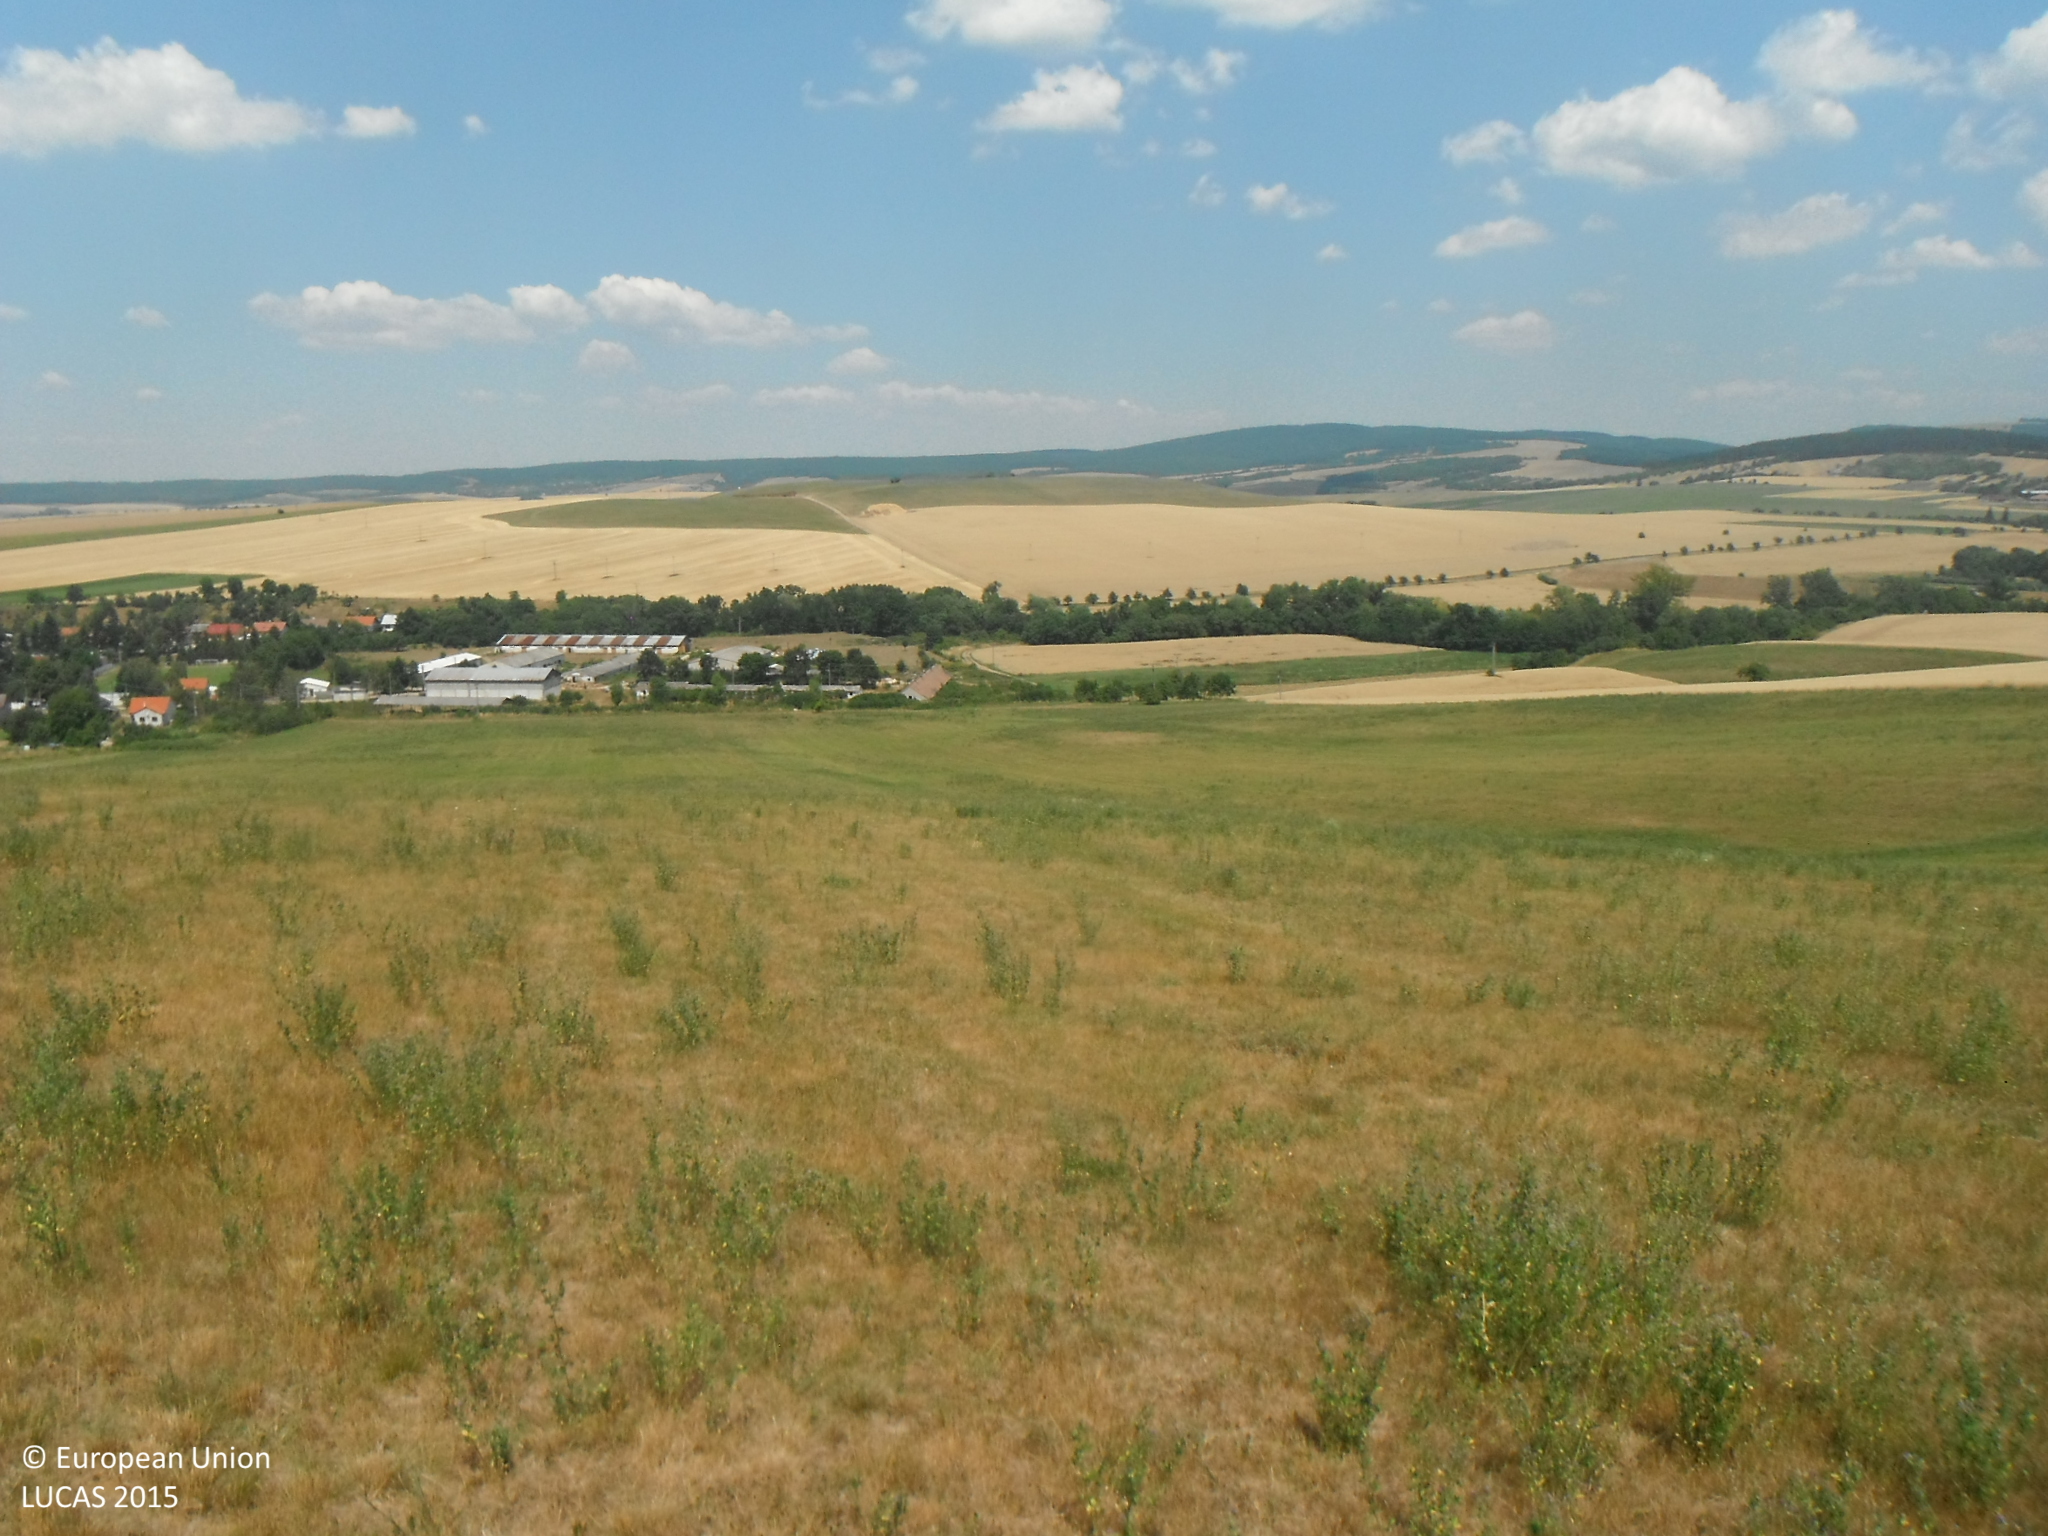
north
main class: Grassland
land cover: Grassland without tree/shrub cover
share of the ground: > 75 %
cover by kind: herbaceous plants 100 %
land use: Agriculture (excluding fallow land and kitchen gardens)
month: July
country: SK
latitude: 48.7393
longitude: 17.3121
